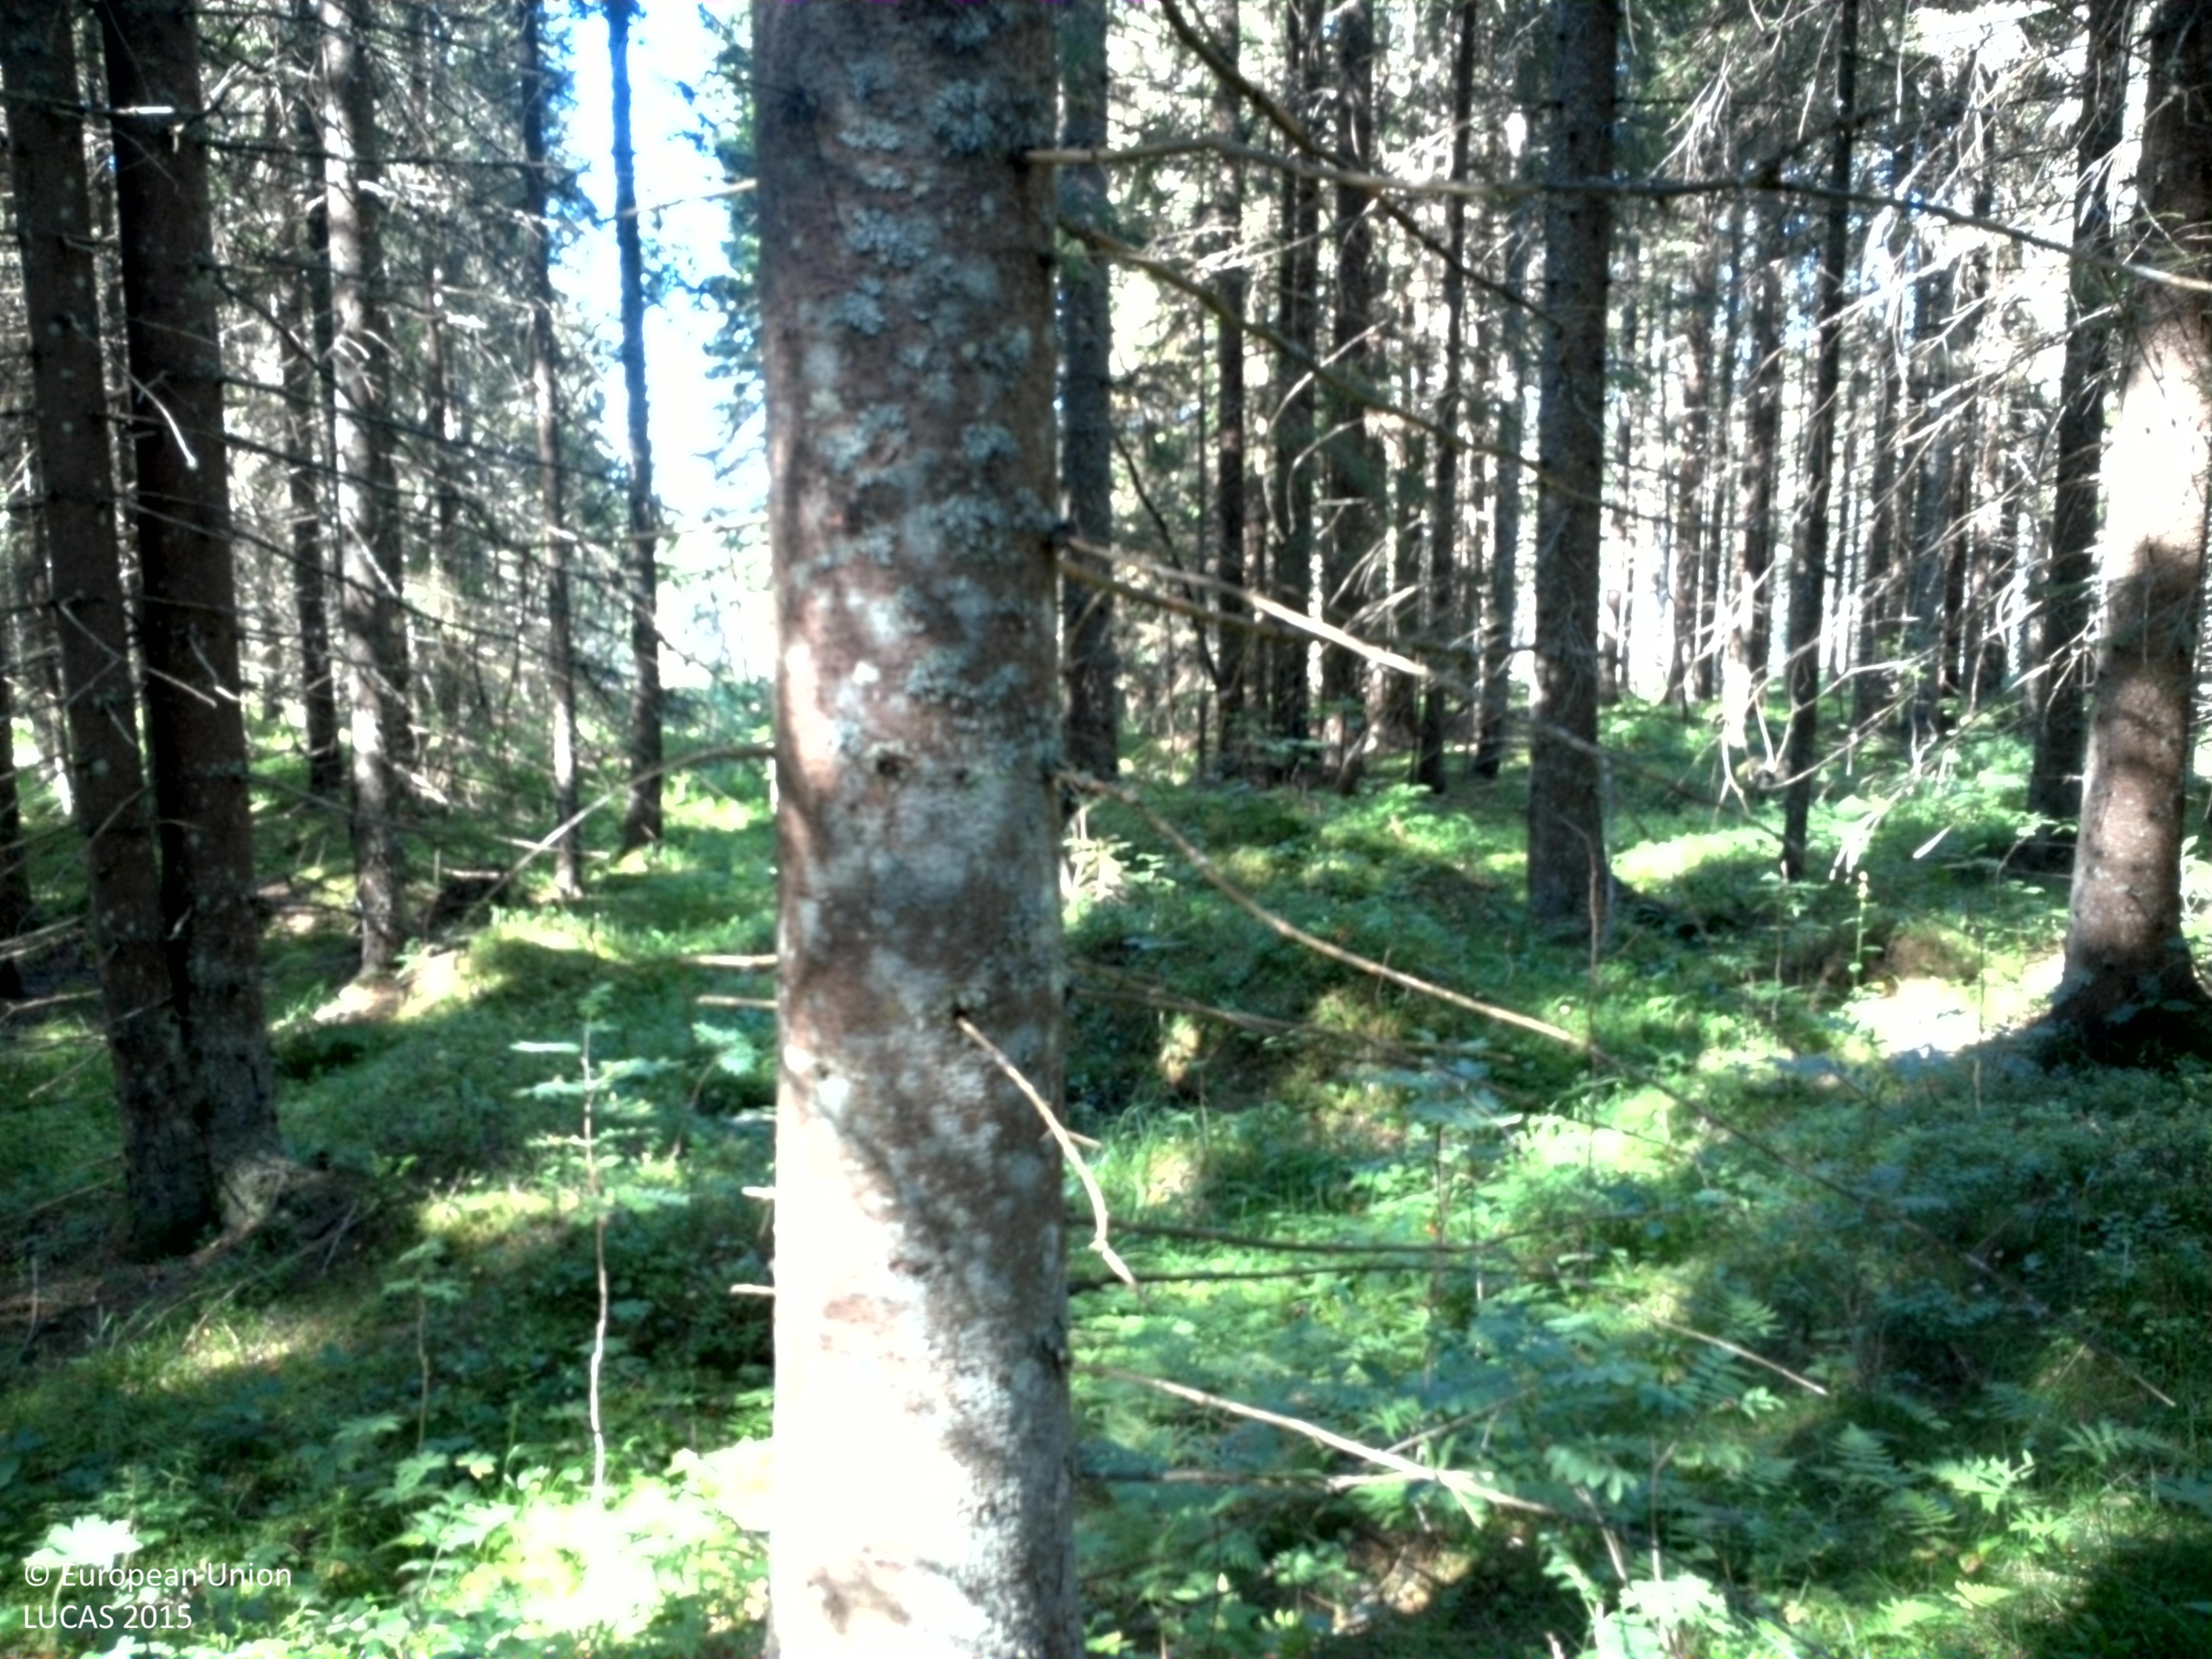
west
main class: Woodland
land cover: Spruce dominated coniferous woodland
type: boreal forest
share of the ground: > 75 %
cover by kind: coniferous forest trees 80 %, lichens and mosses 10 %, shrubs 5 %, herbaceous plants 5 %
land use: Forestry
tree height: > 5 m
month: August
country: SE
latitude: 59.9591
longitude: 14.0910
